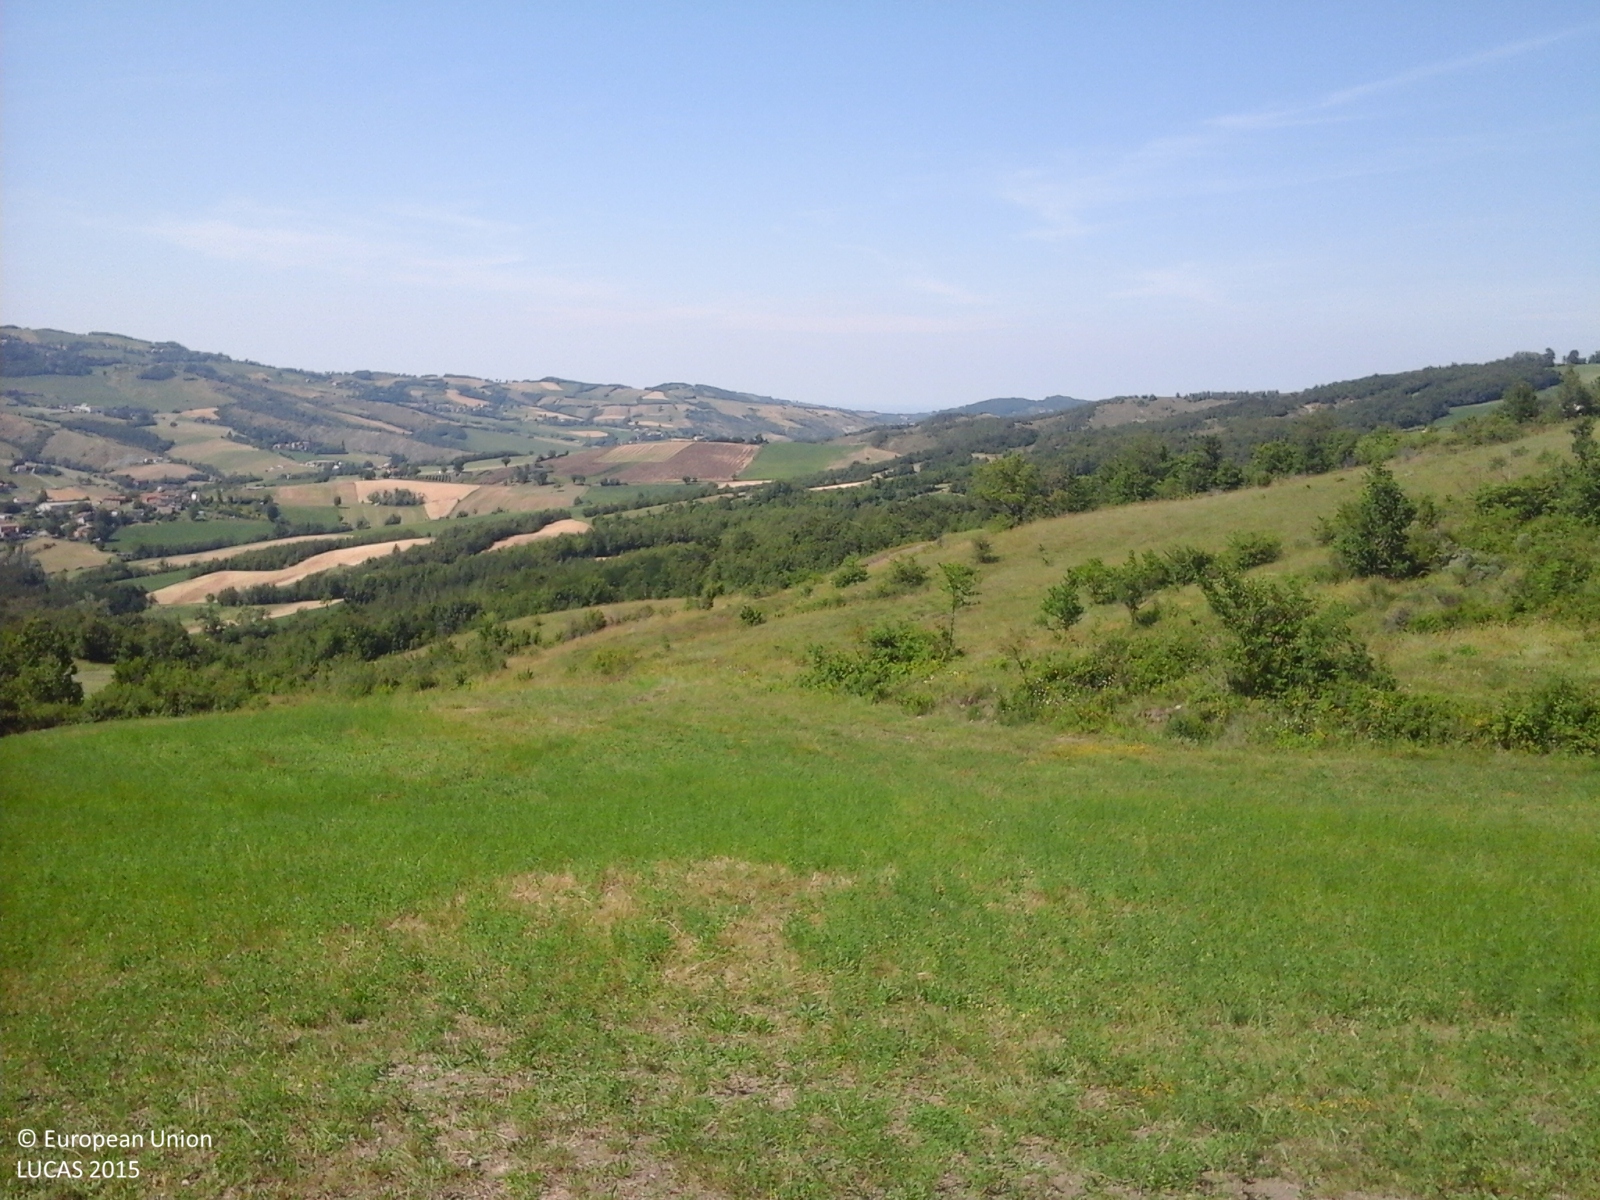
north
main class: Grassland
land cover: Grassland without tree/shrub cover
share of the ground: > 75 %
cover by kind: herbaceous plants 100 %
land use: Agriculture (excluding fallow land and kitchen gardens)
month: June
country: IT
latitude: 44.5484
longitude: 10.3391
